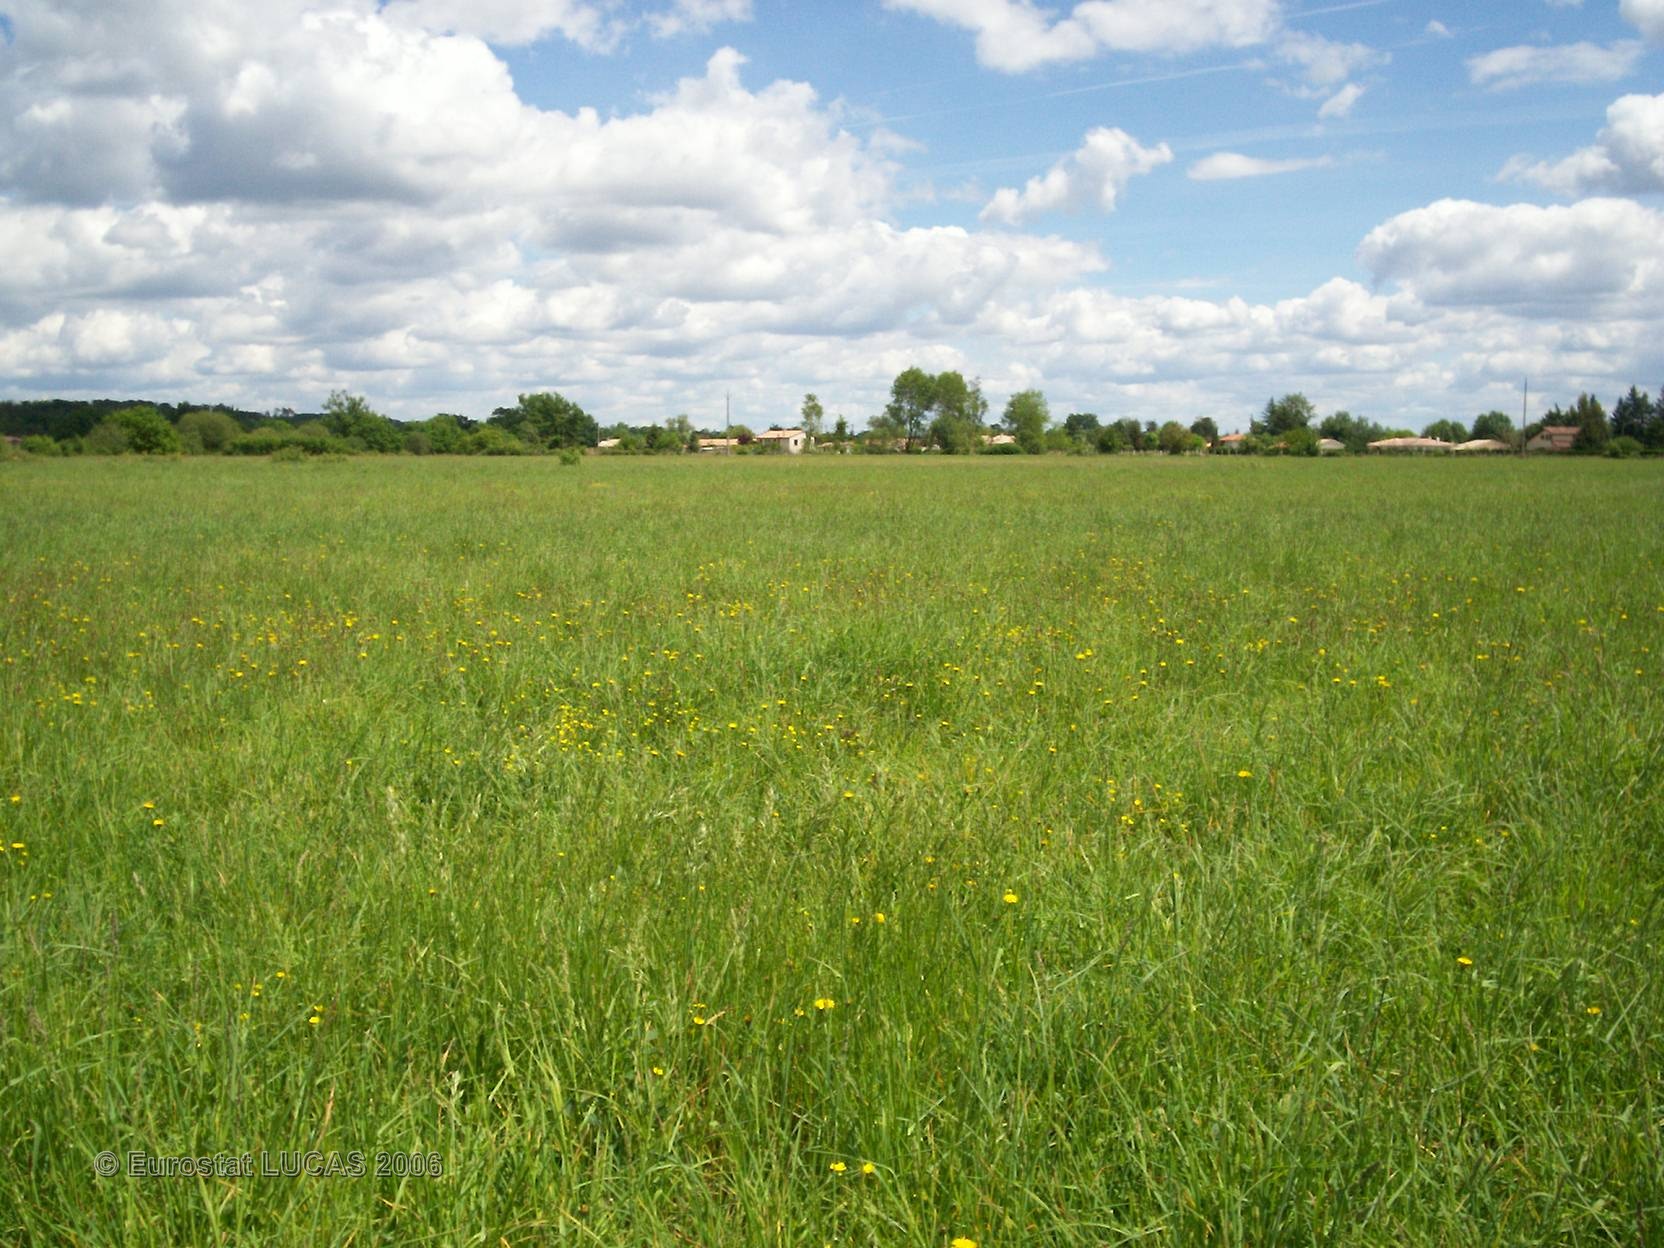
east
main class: Grassland
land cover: Grassland without tree/shrub cover
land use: Agriculture (excluding fallow land and kitchen gardens)
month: May
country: FR
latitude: 45.0282
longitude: -0.0032
